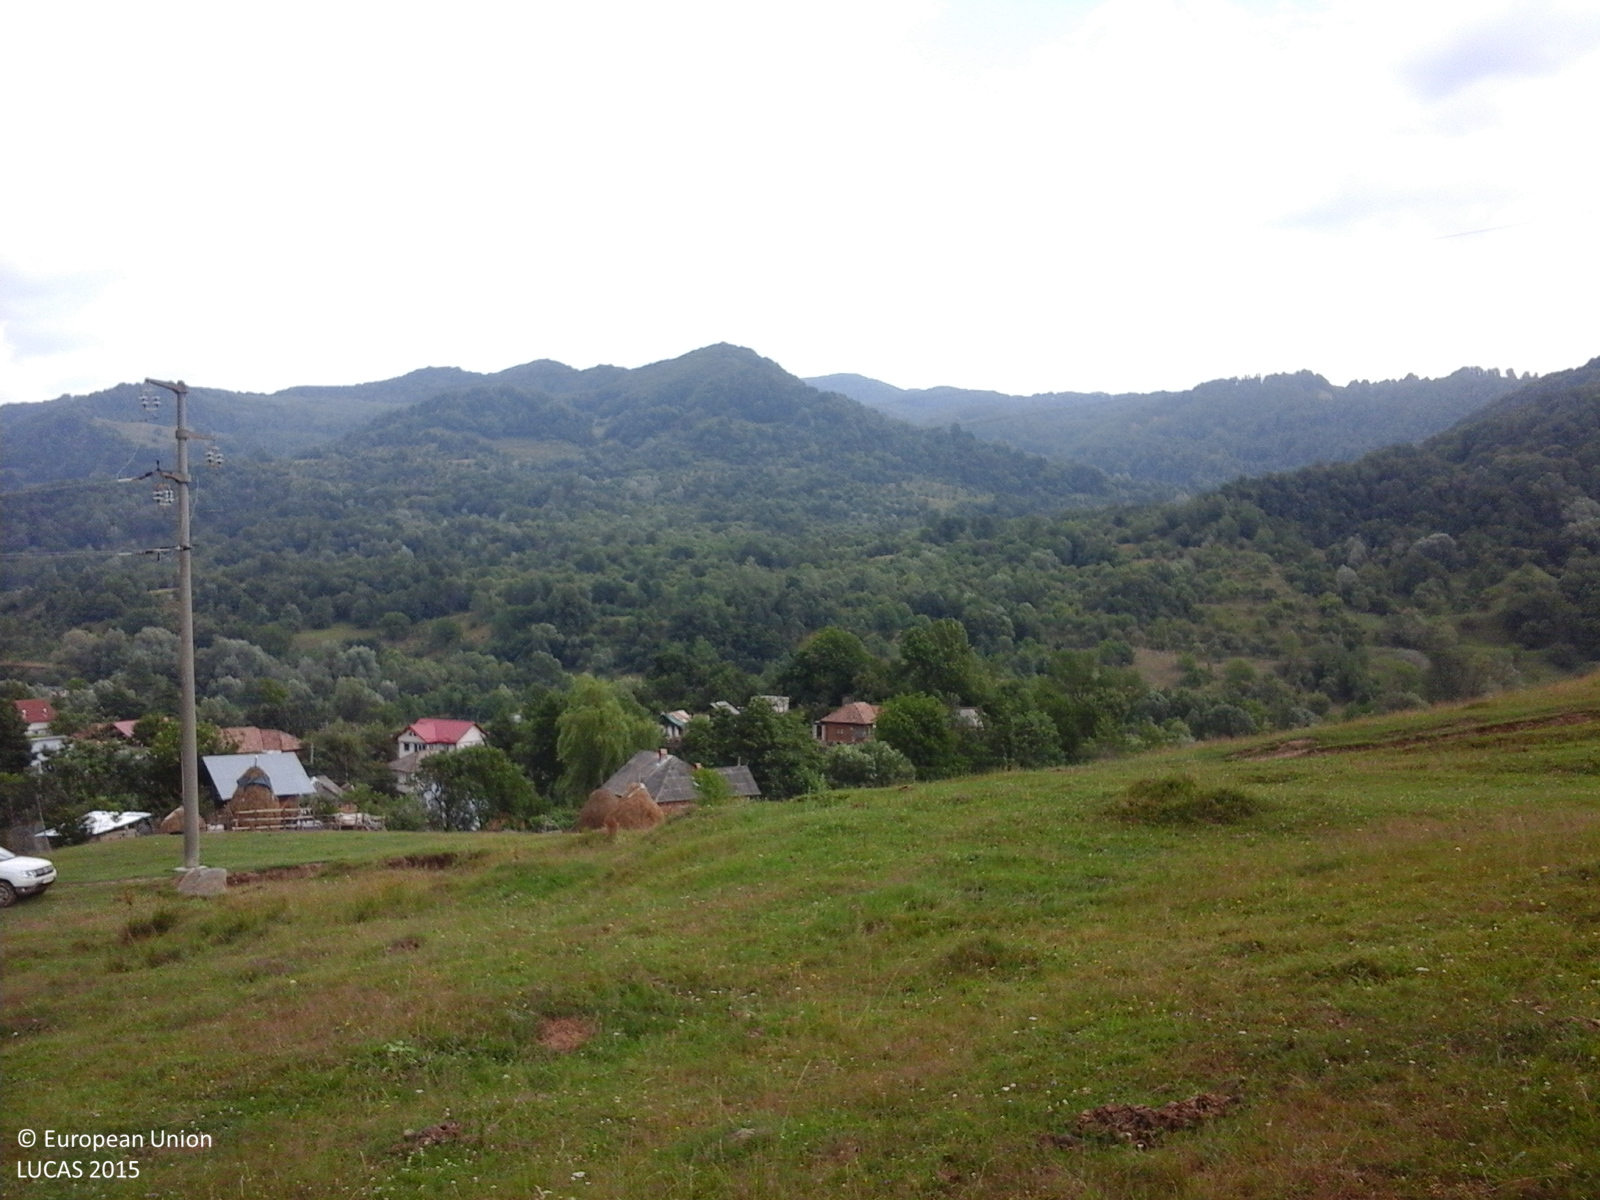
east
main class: Grassland
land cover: Grassland without tree/shrub cover
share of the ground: > 75 %
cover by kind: herbaceous plants 100 %
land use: Agriculture (excluding fallow land and kitchen gardens)
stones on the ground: < 10 %
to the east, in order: Grassland without tree/shrub cover; Tracks; Electric lines; Grassland without tree/shrub cover; Artificial constructions in urban areas
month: July
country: RO
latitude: 45.2806
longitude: 24.6520
